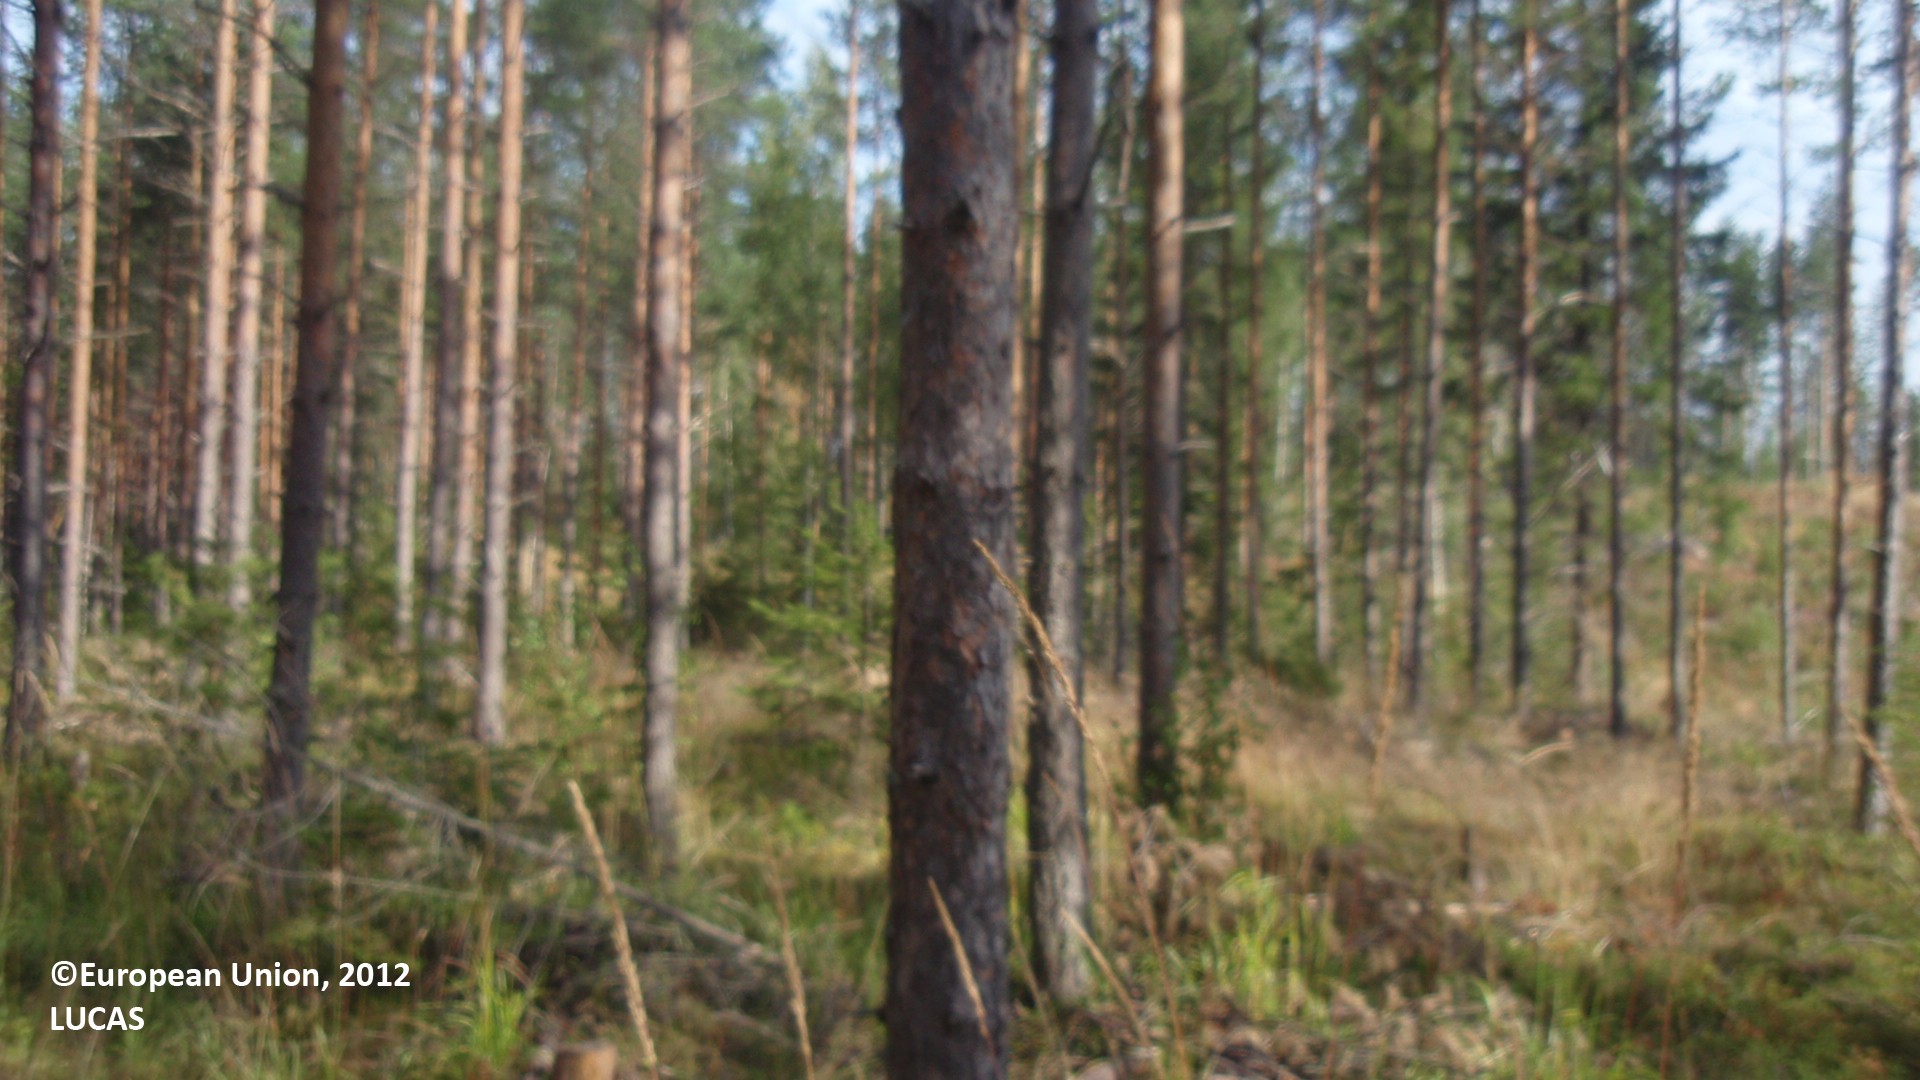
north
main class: Woodland
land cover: Pine dominated coniferous woodland
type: boreal forest
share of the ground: 50 - 75 %
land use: Forestry
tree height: > 5 m
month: August
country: FI
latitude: 61.3635
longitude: 27.2485
